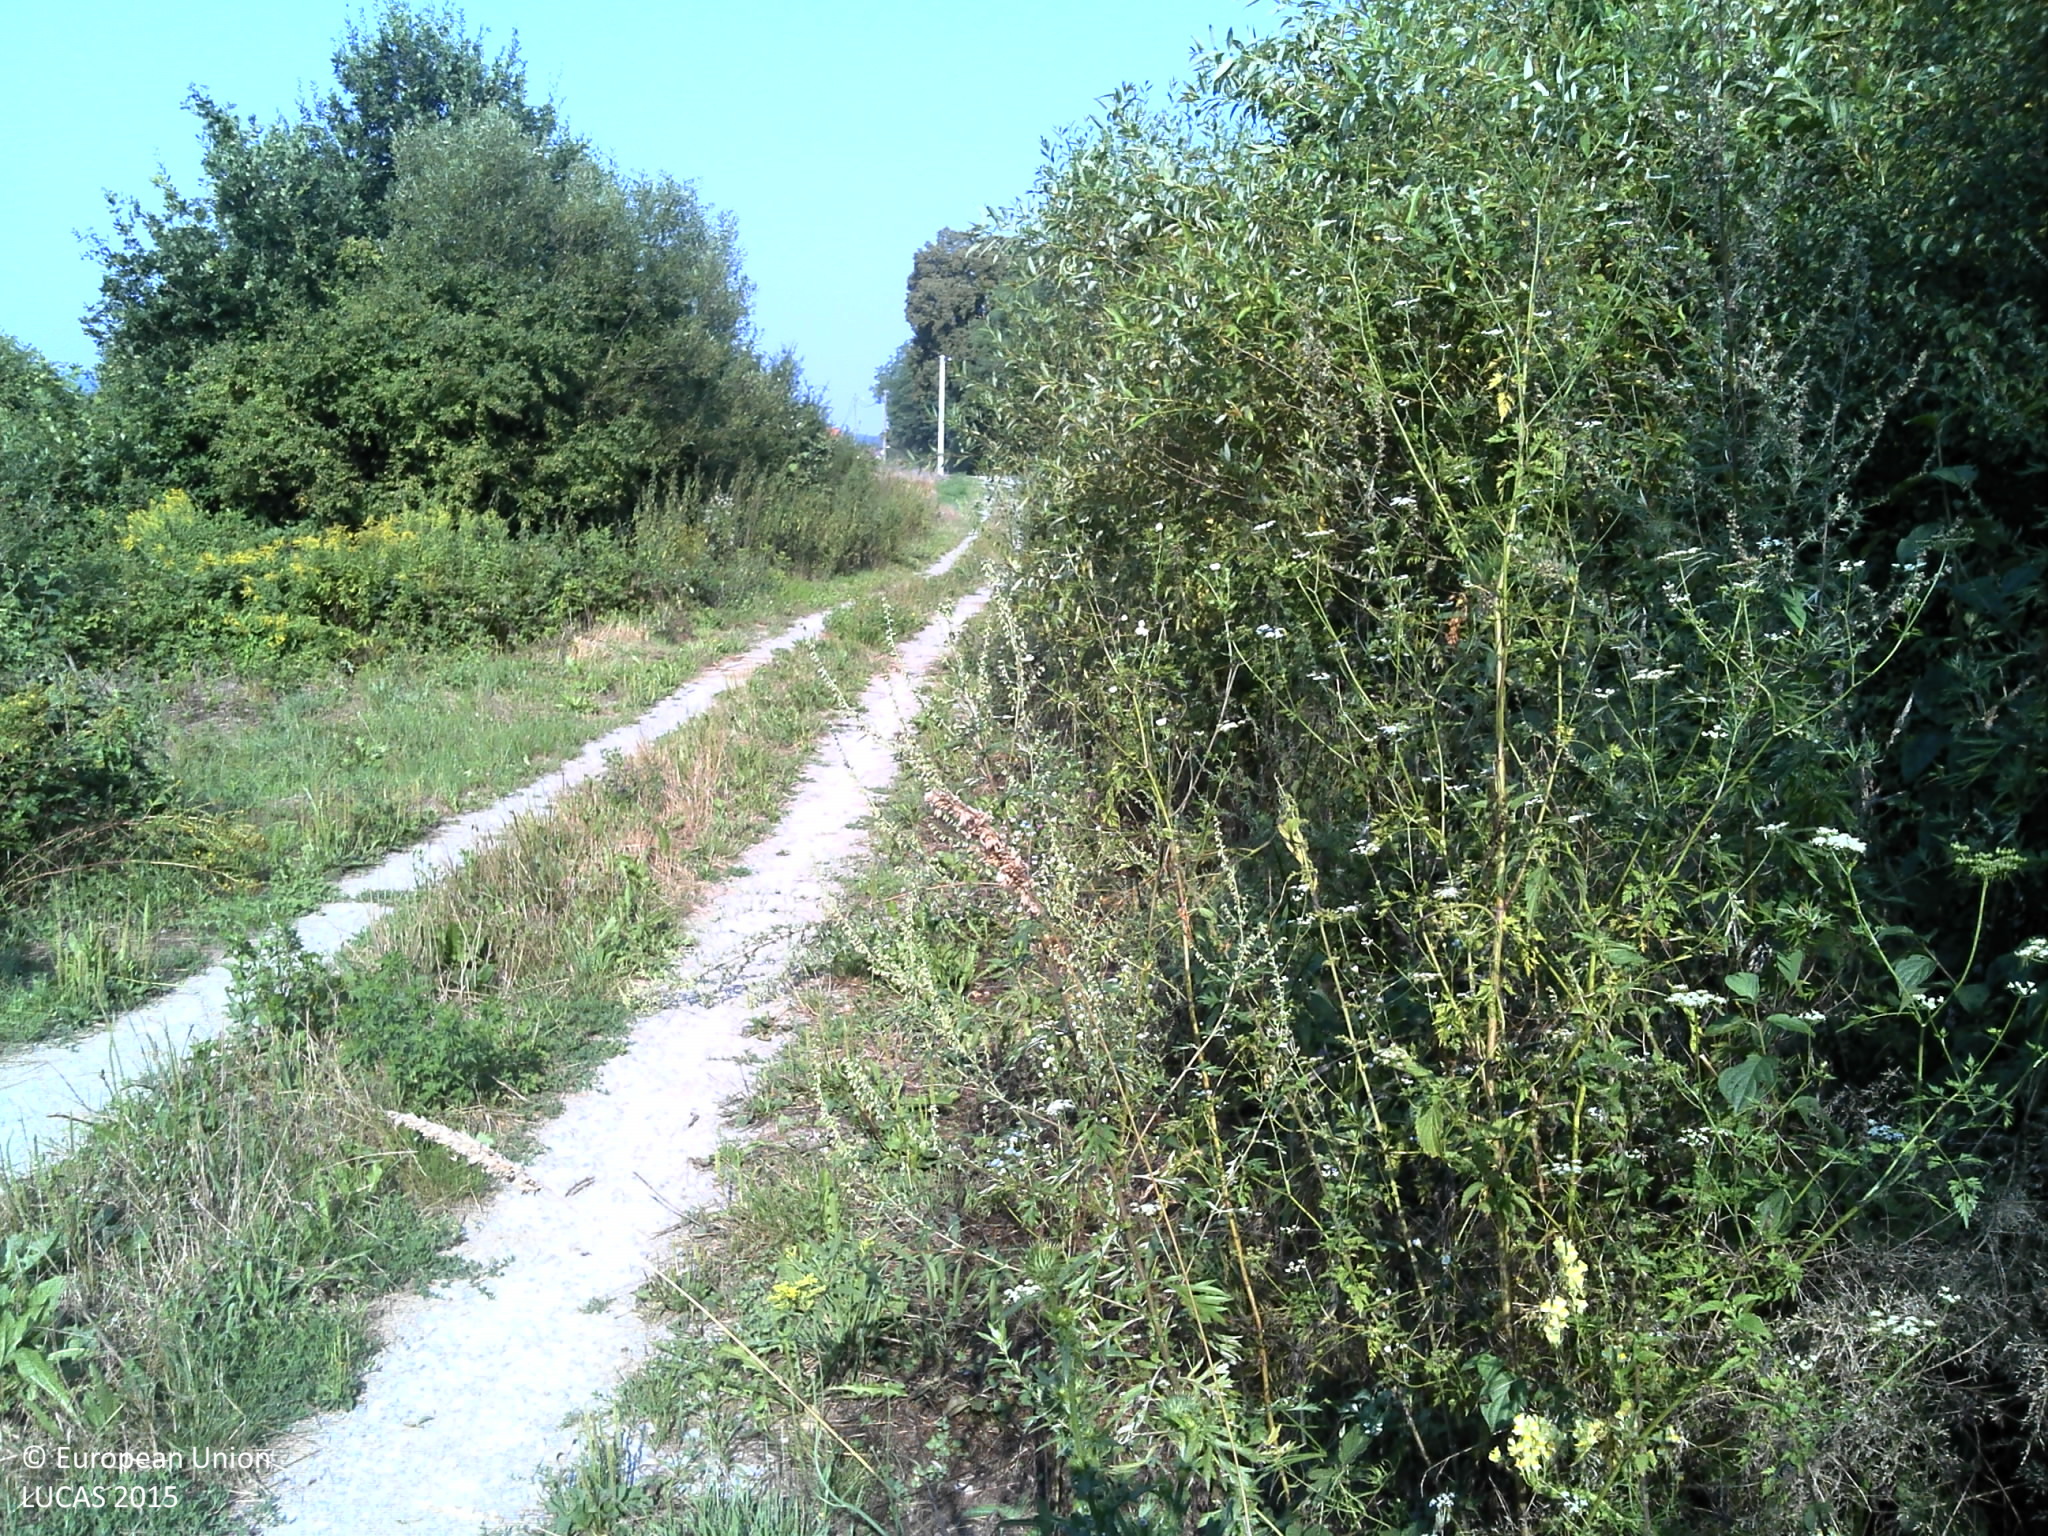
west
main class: Shrubland
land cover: Shrubland without tree cover
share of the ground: > 75 %
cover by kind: shrubs 100 %
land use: Forestry
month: August
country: HR
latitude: 45.6409
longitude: 16.8893
